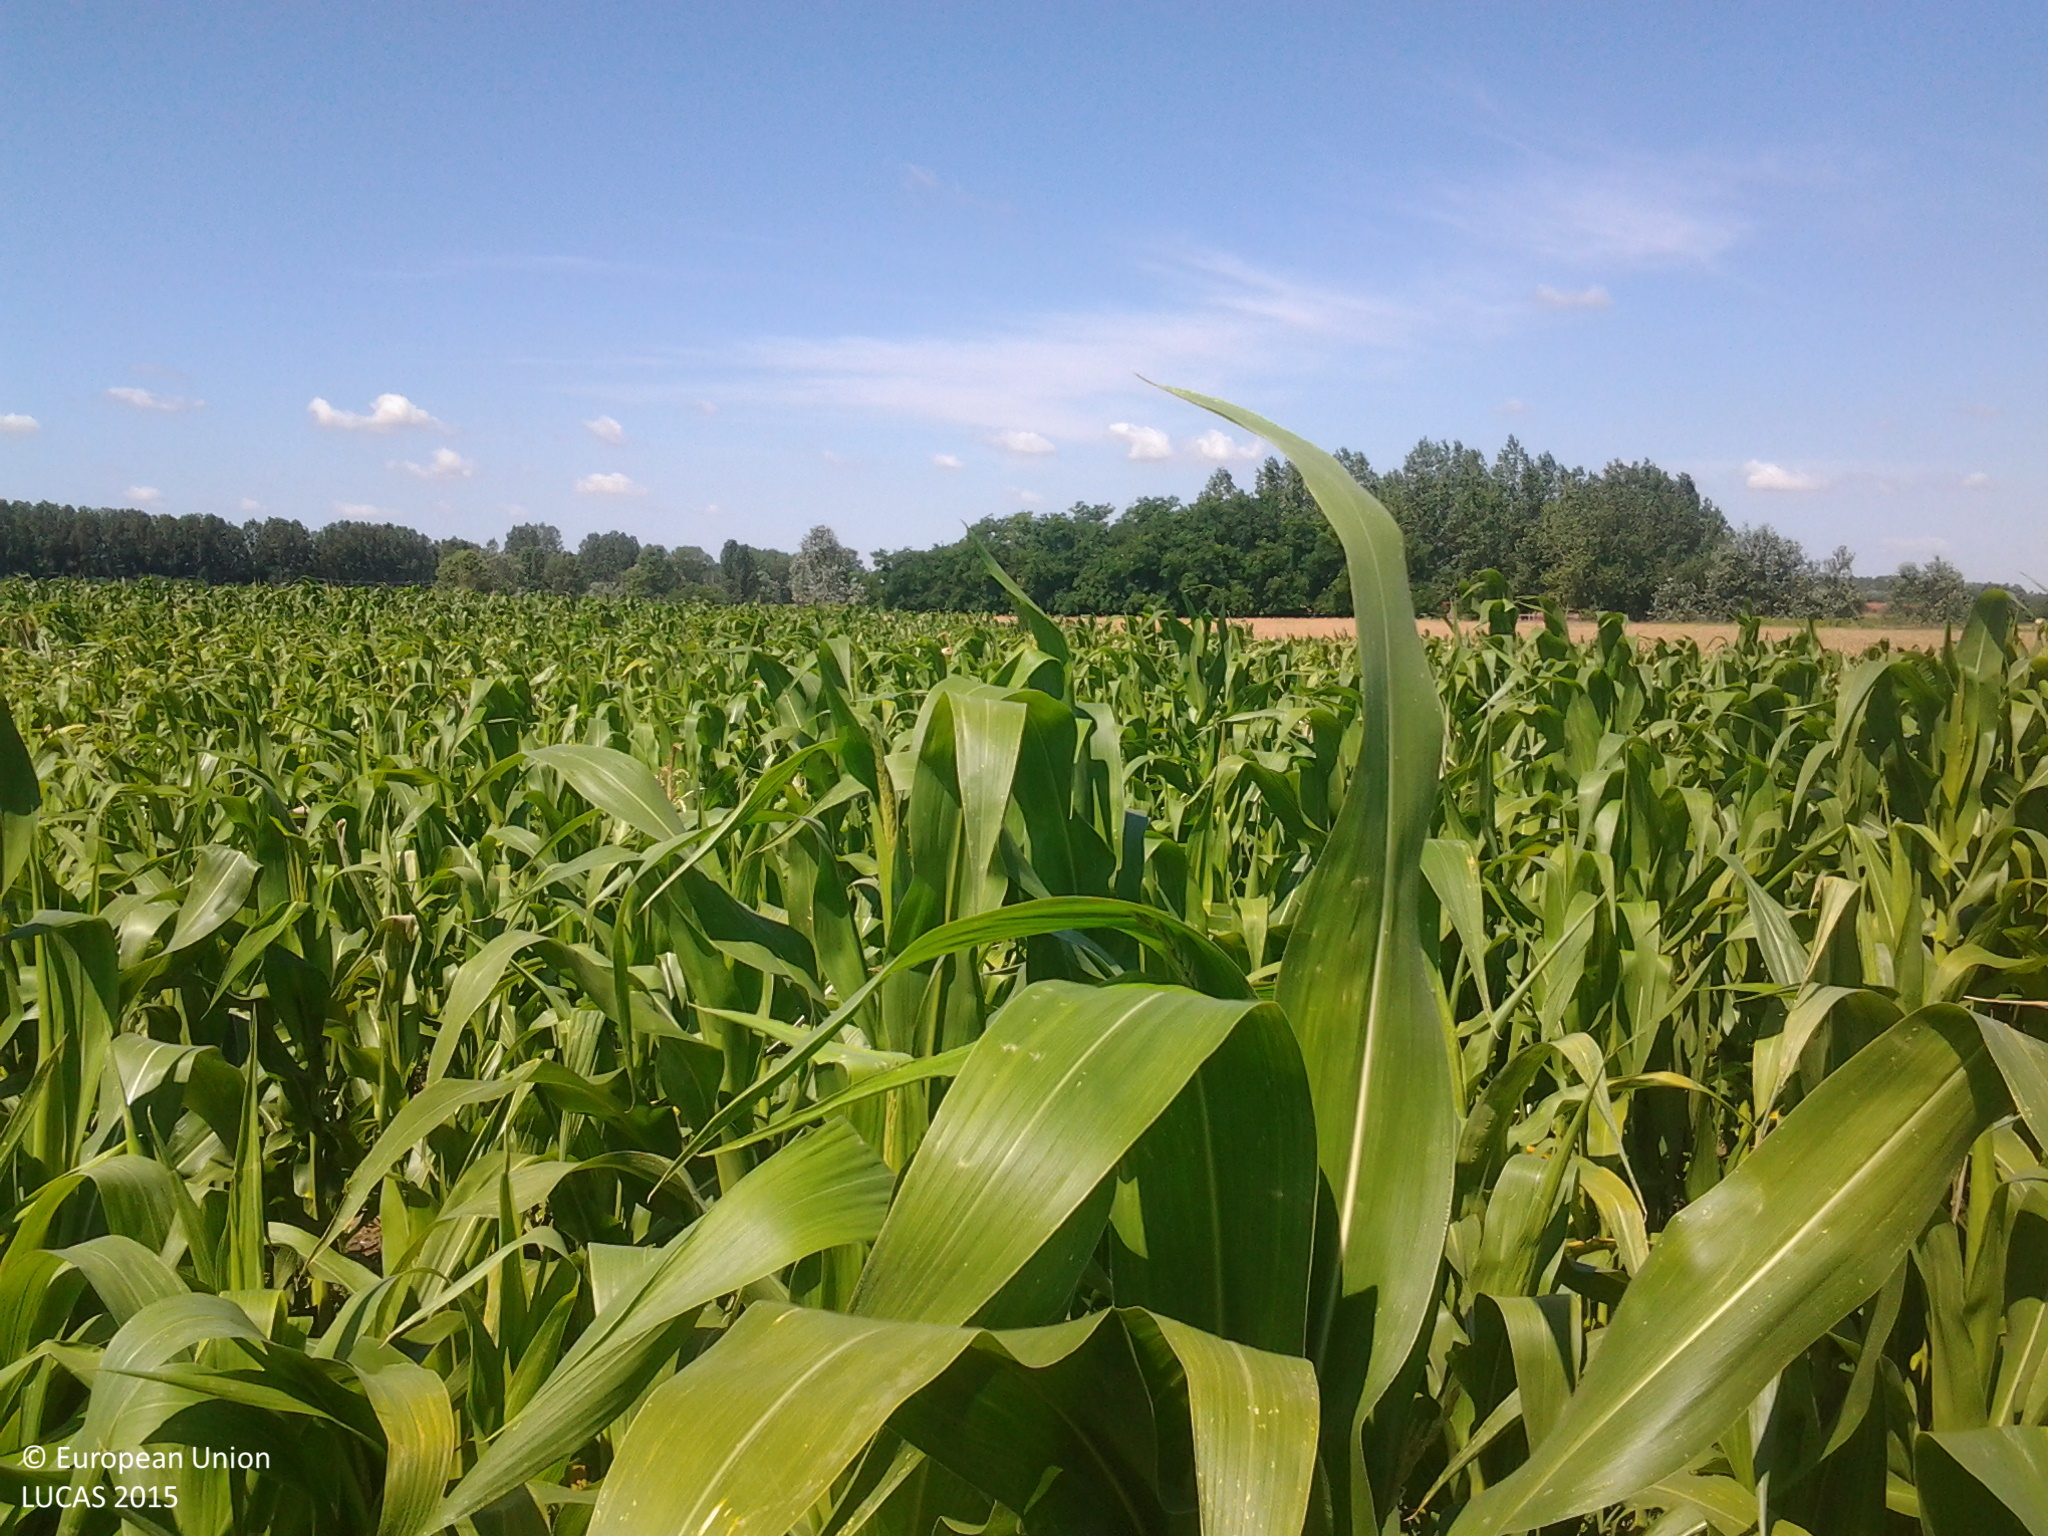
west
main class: Cropland
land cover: Maize
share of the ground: > 75 %
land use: Agriculture (excluding fallow land and kitchen gardens)
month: July
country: HU
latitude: 46.5596
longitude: 19.5273
